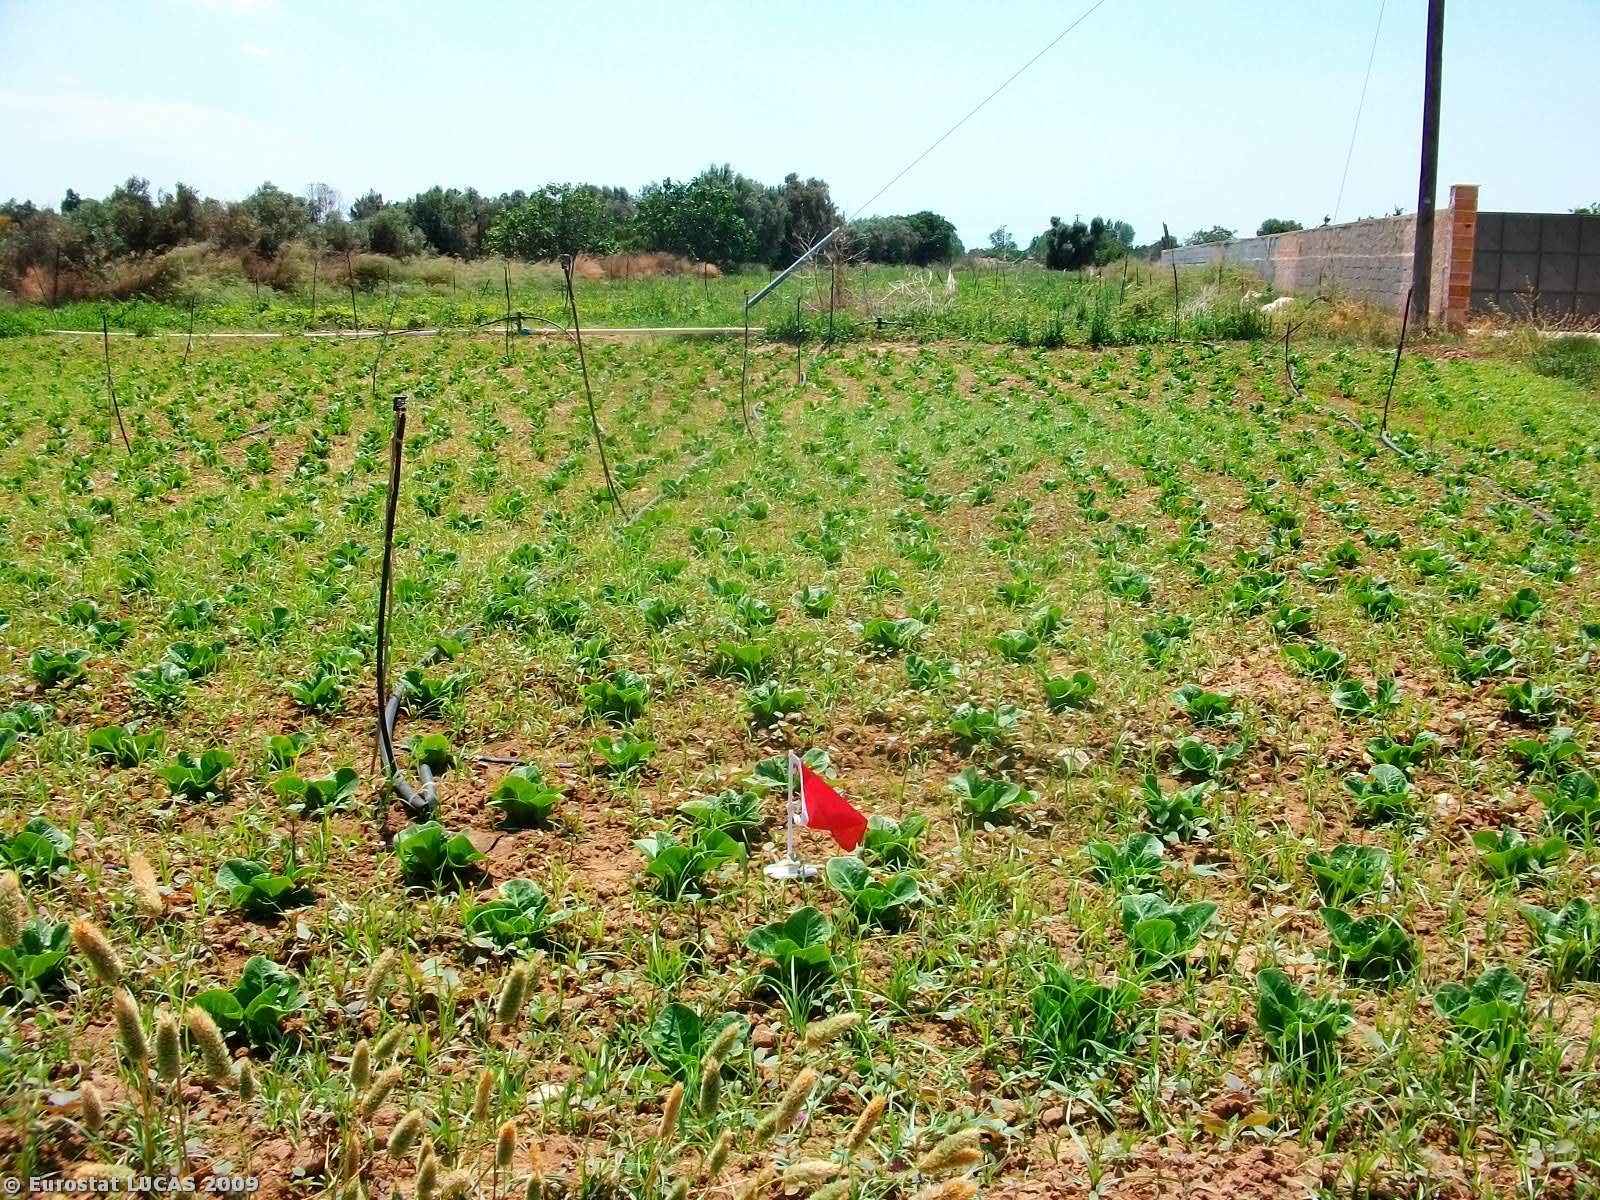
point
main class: Cropland
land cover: Other fresh vegetables
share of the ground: 50 - 75 %
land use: Agriculture (excluding fallow land and kitchen gardens)
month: May
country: GR
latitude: 38.1411
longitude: 23.9856
